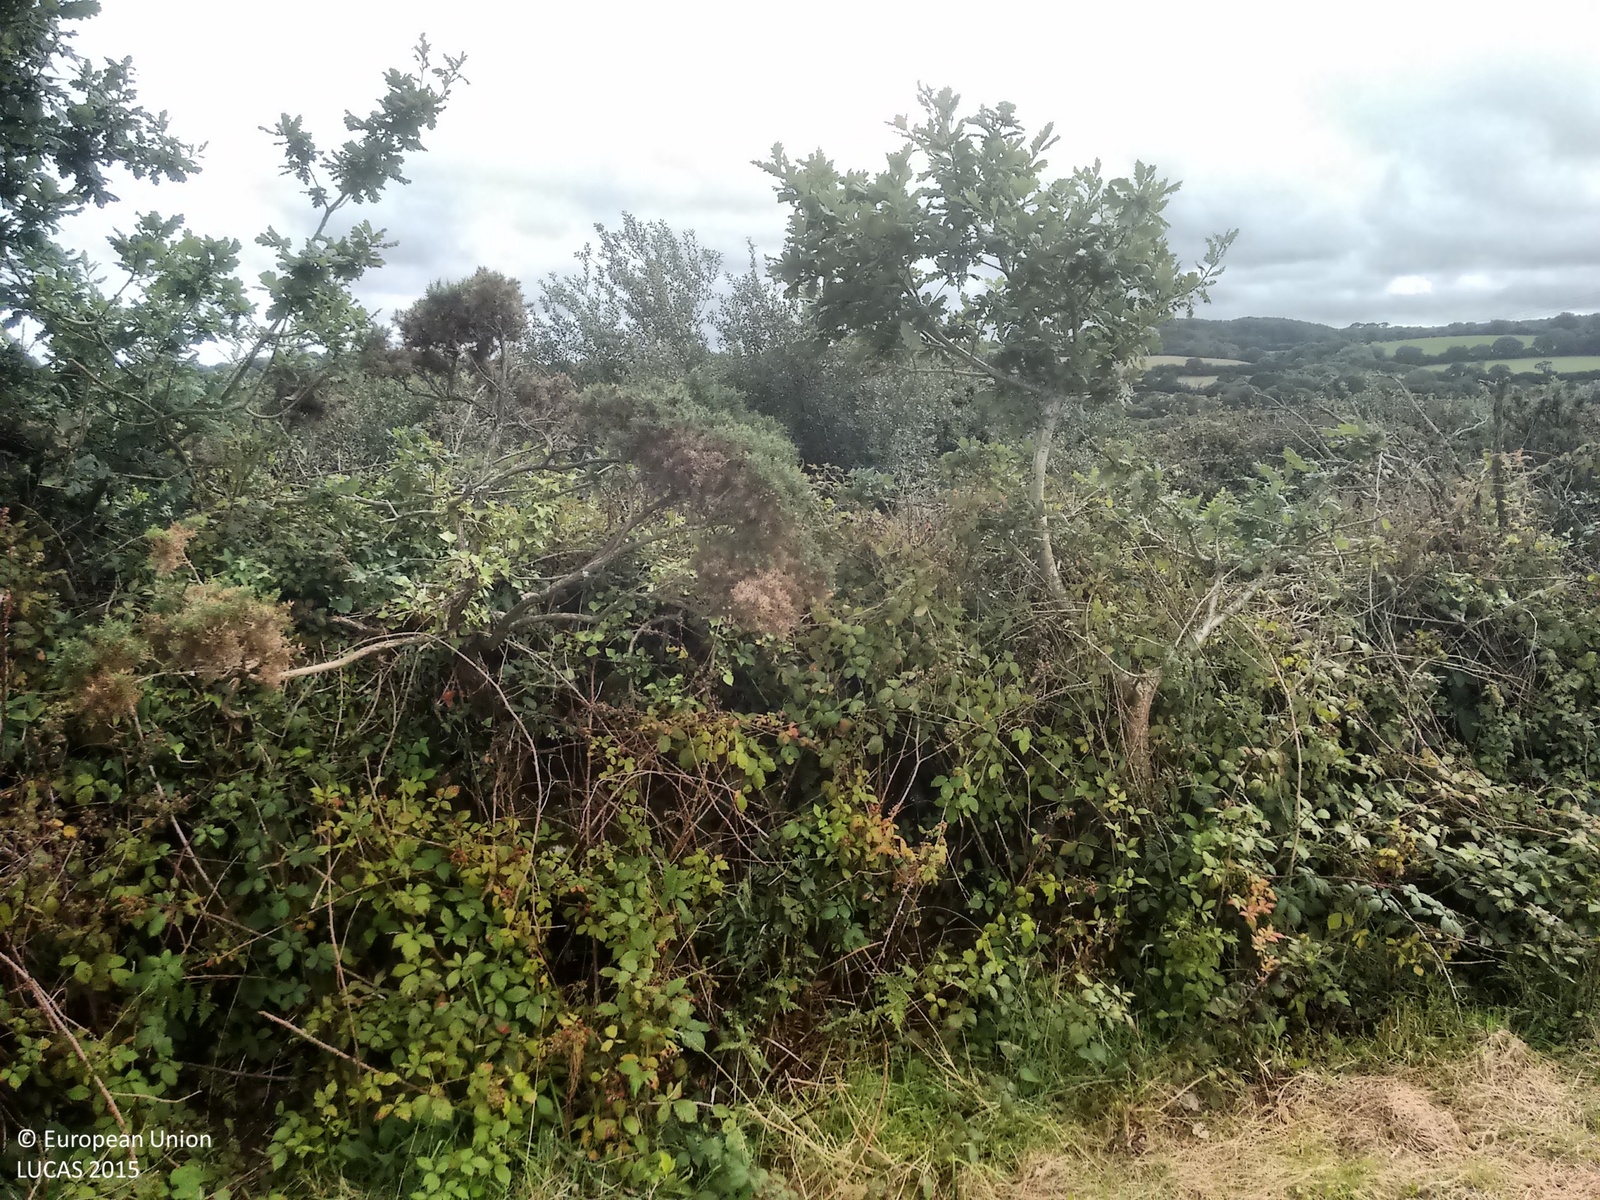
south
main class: Grassland
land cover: Grassland without tree/shrub cover
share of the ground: > 75 %
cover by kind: herbaceous plants 100 %
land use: Agriculture (excluding fallow land and kitchen gardens)
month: August
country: GB
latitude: 50.2243
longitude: -5.1591
